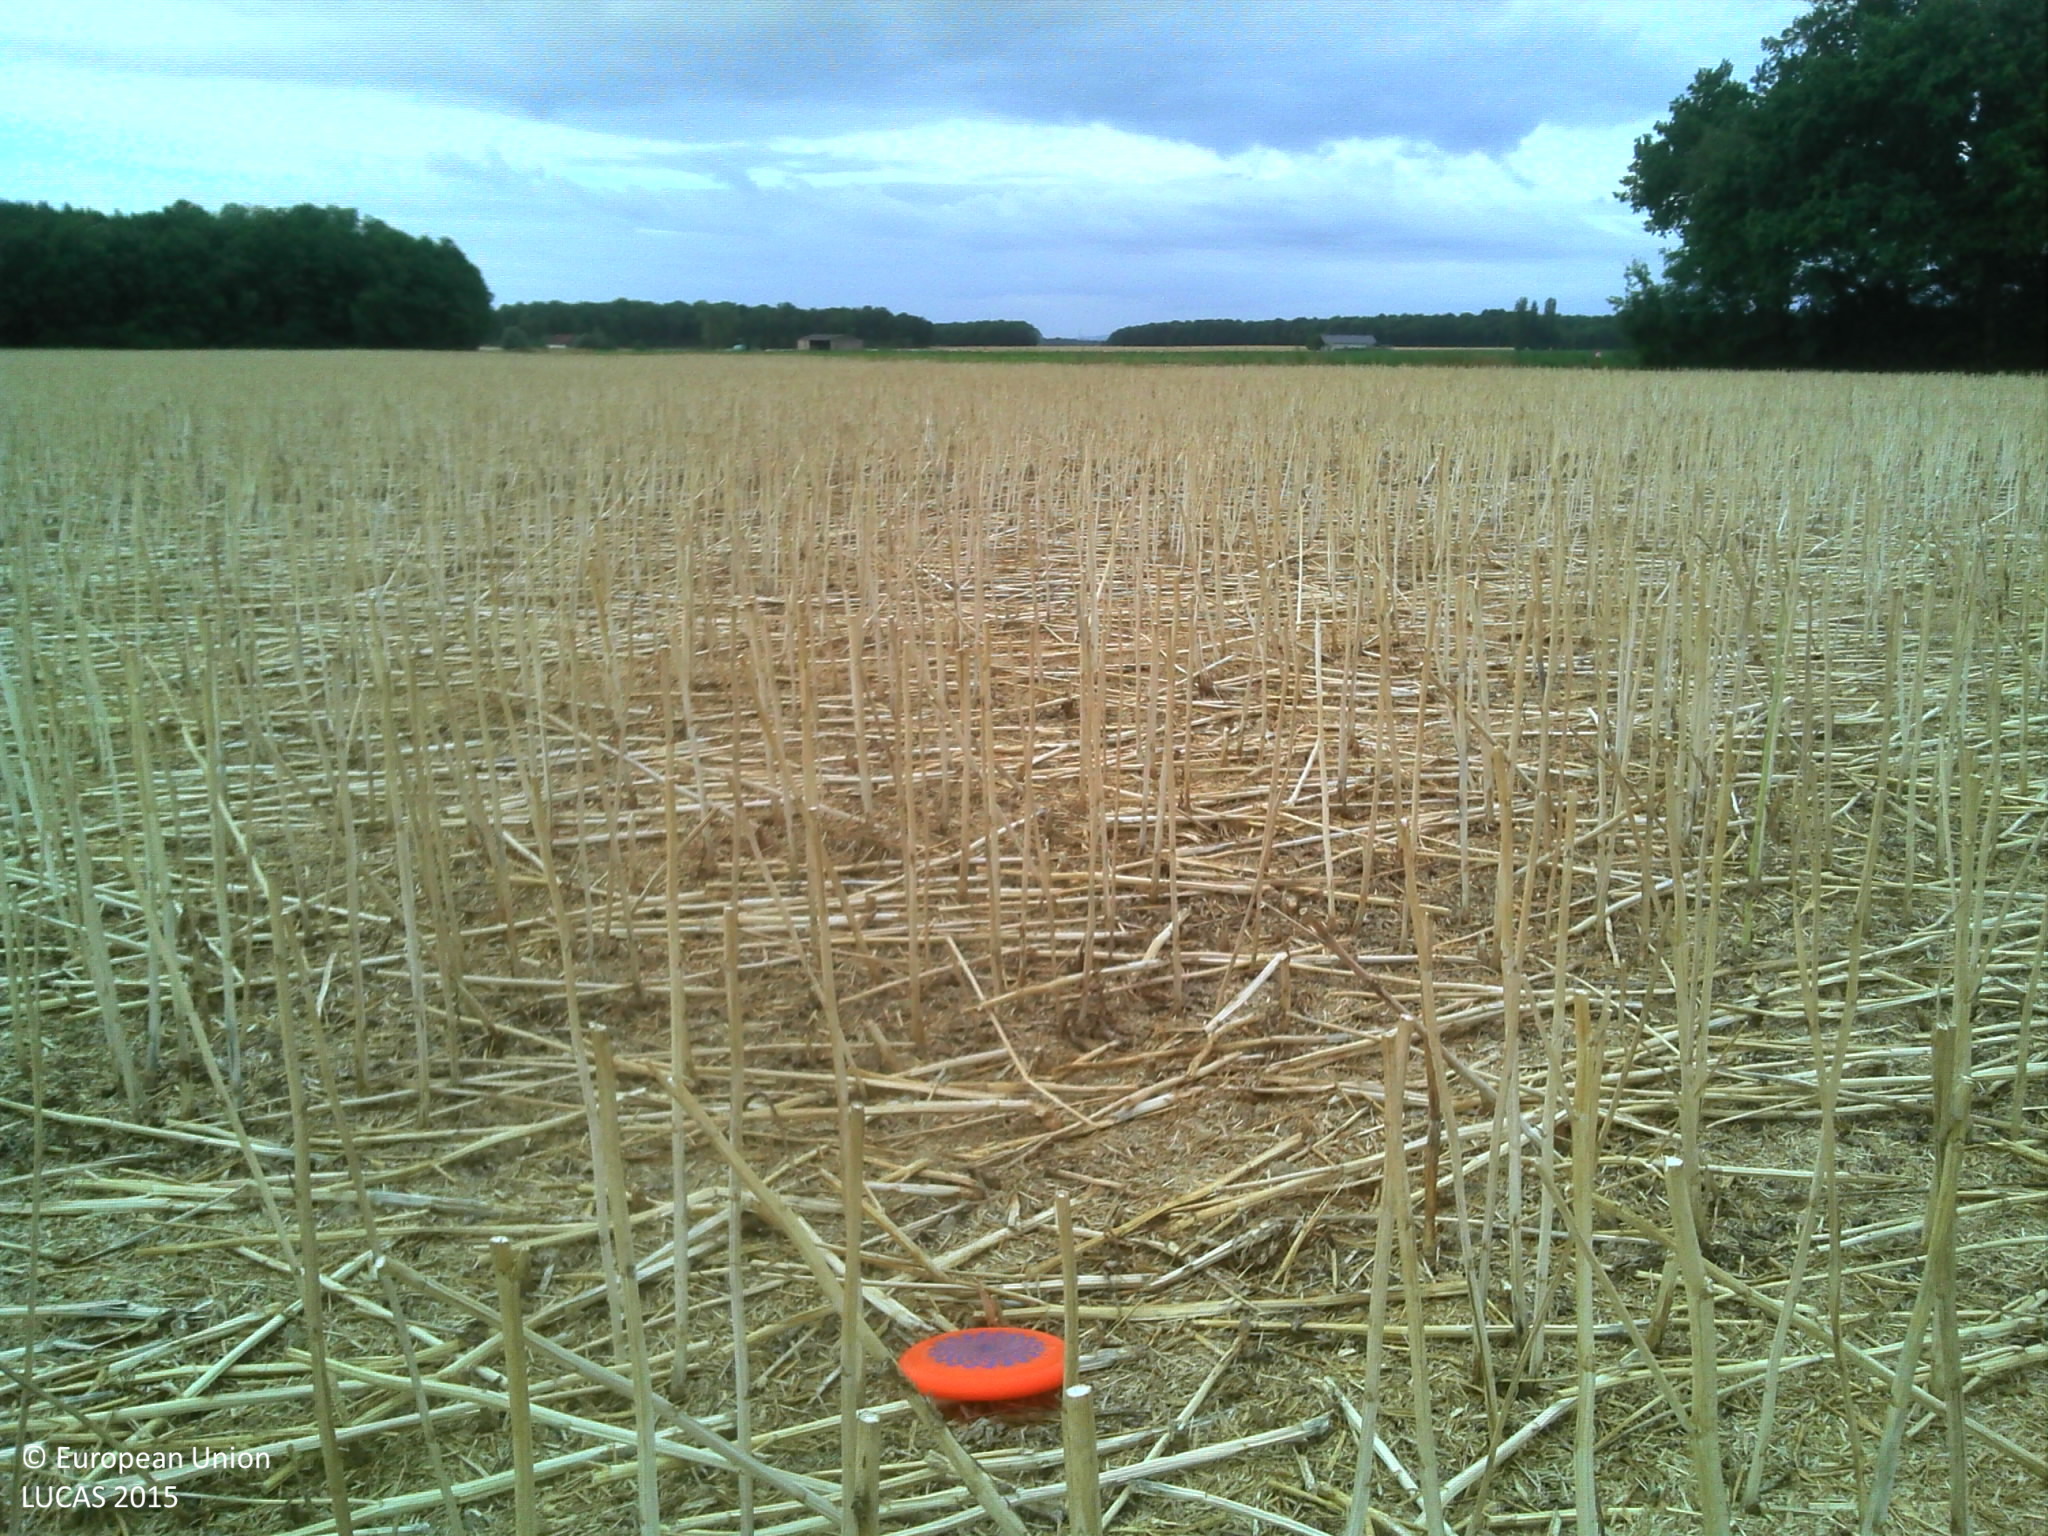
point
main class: Cropland
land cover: Rape and turnip rape
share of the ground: < 10 %
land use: Agriculture (excluding fallow land and kitchen gardens)
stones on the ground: < 10 %
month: July
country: FR
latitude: 46.8778
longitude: 4.8707
